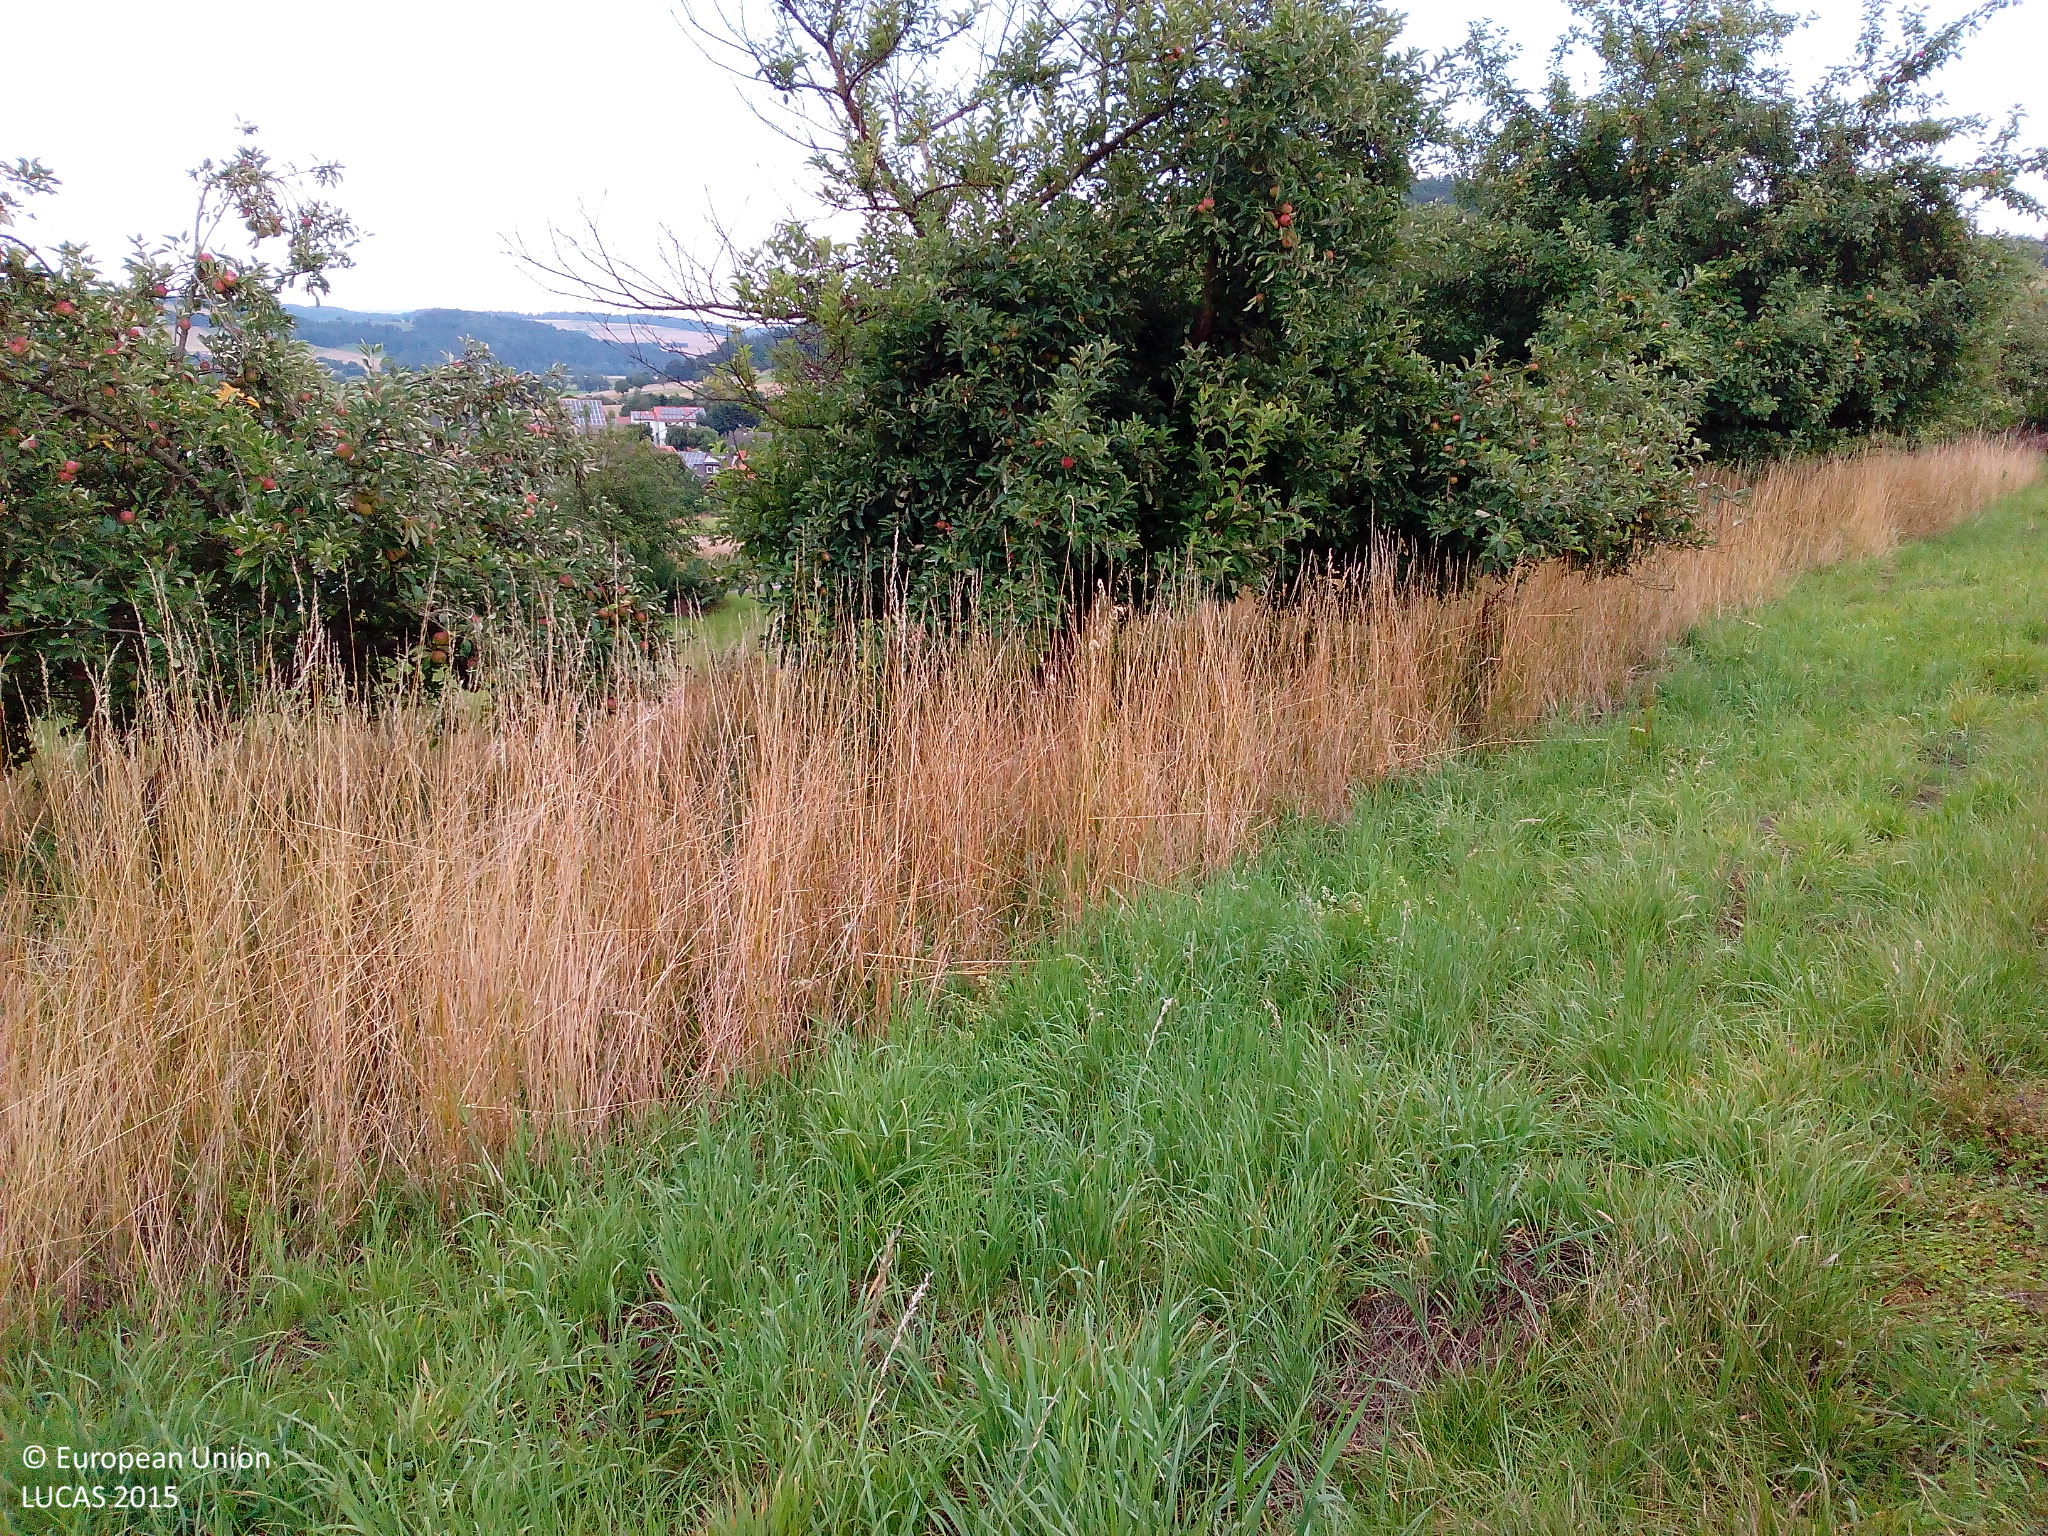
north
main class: Cropland
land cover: Common wheat
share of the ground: > 75 %
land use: Agriculture (excluding fallow land and kitchen gardens)
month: August
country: DE
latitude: 50.7409
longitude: 9.5892
